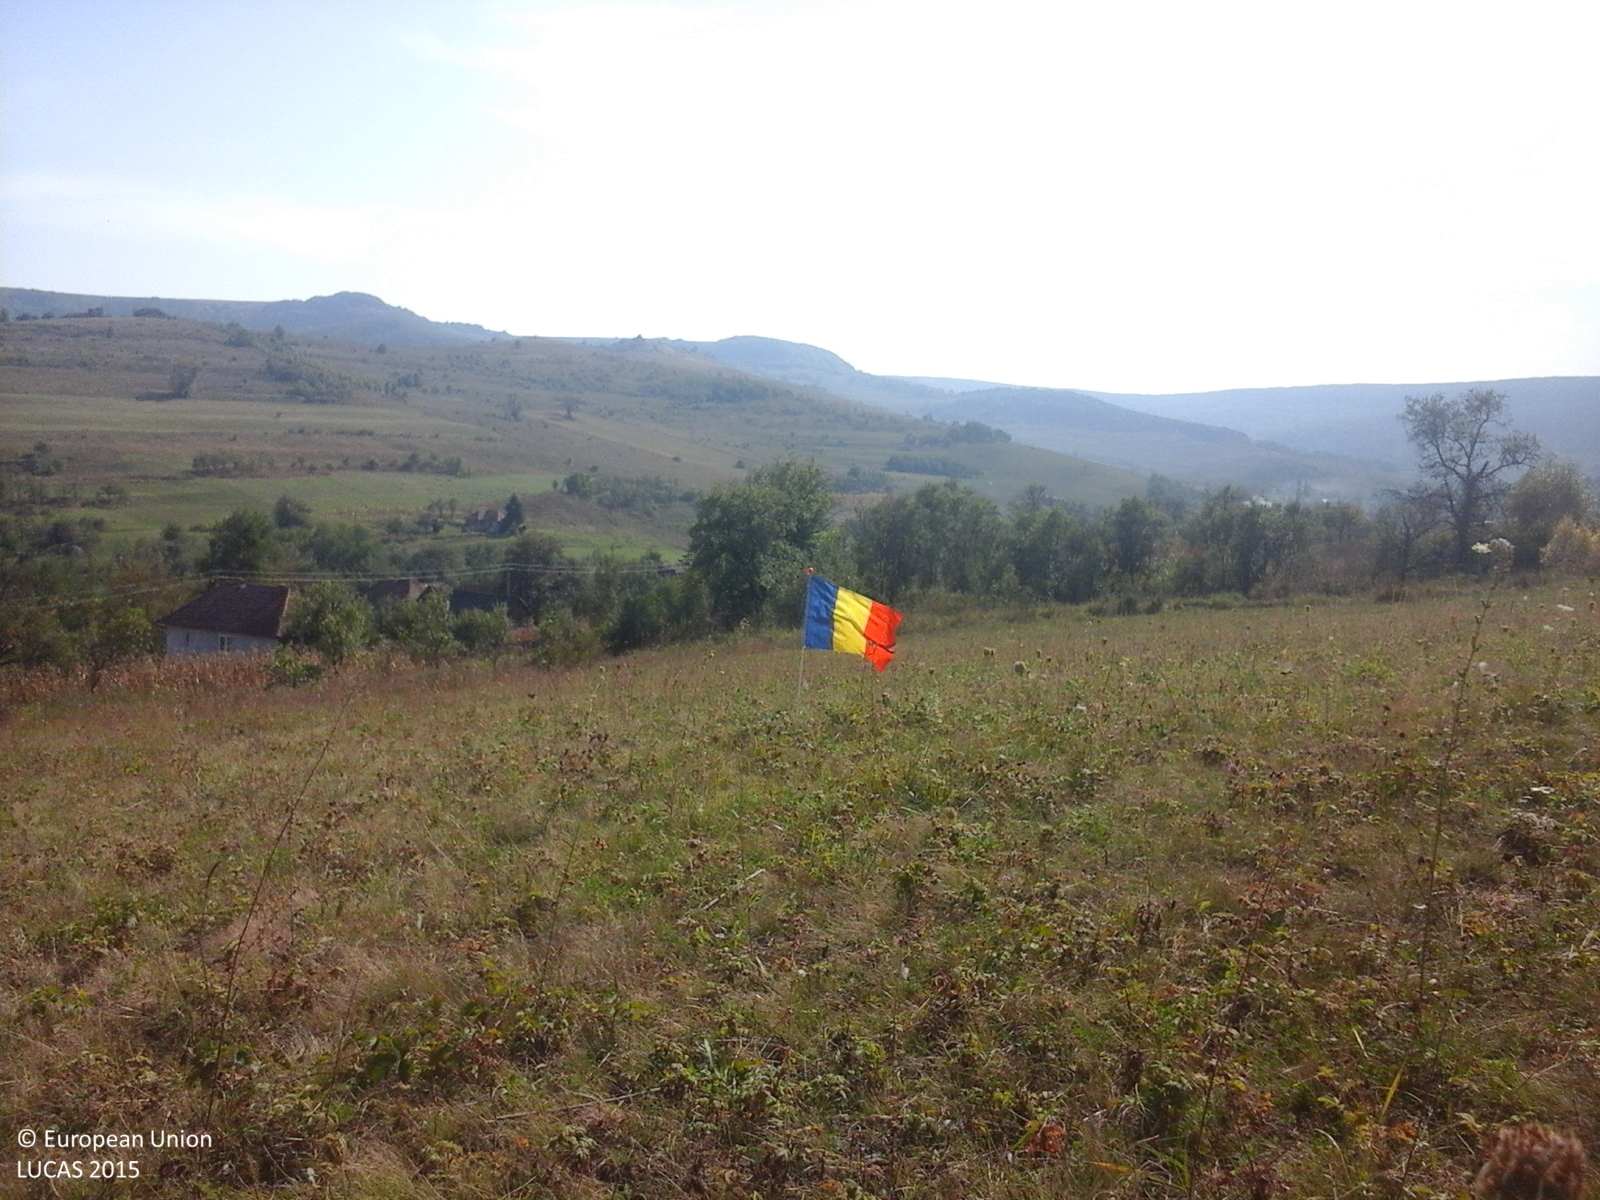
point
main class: Grassland
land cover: Grassland without tree/shrub cover
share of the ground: > 75 %
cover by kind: herbaceous plants 100 %
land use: Agriculture (excluding fallow land and kitchen gardens)
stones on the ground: < 10 %
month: September
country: RO
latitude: 47.1269
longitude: 23.6924
